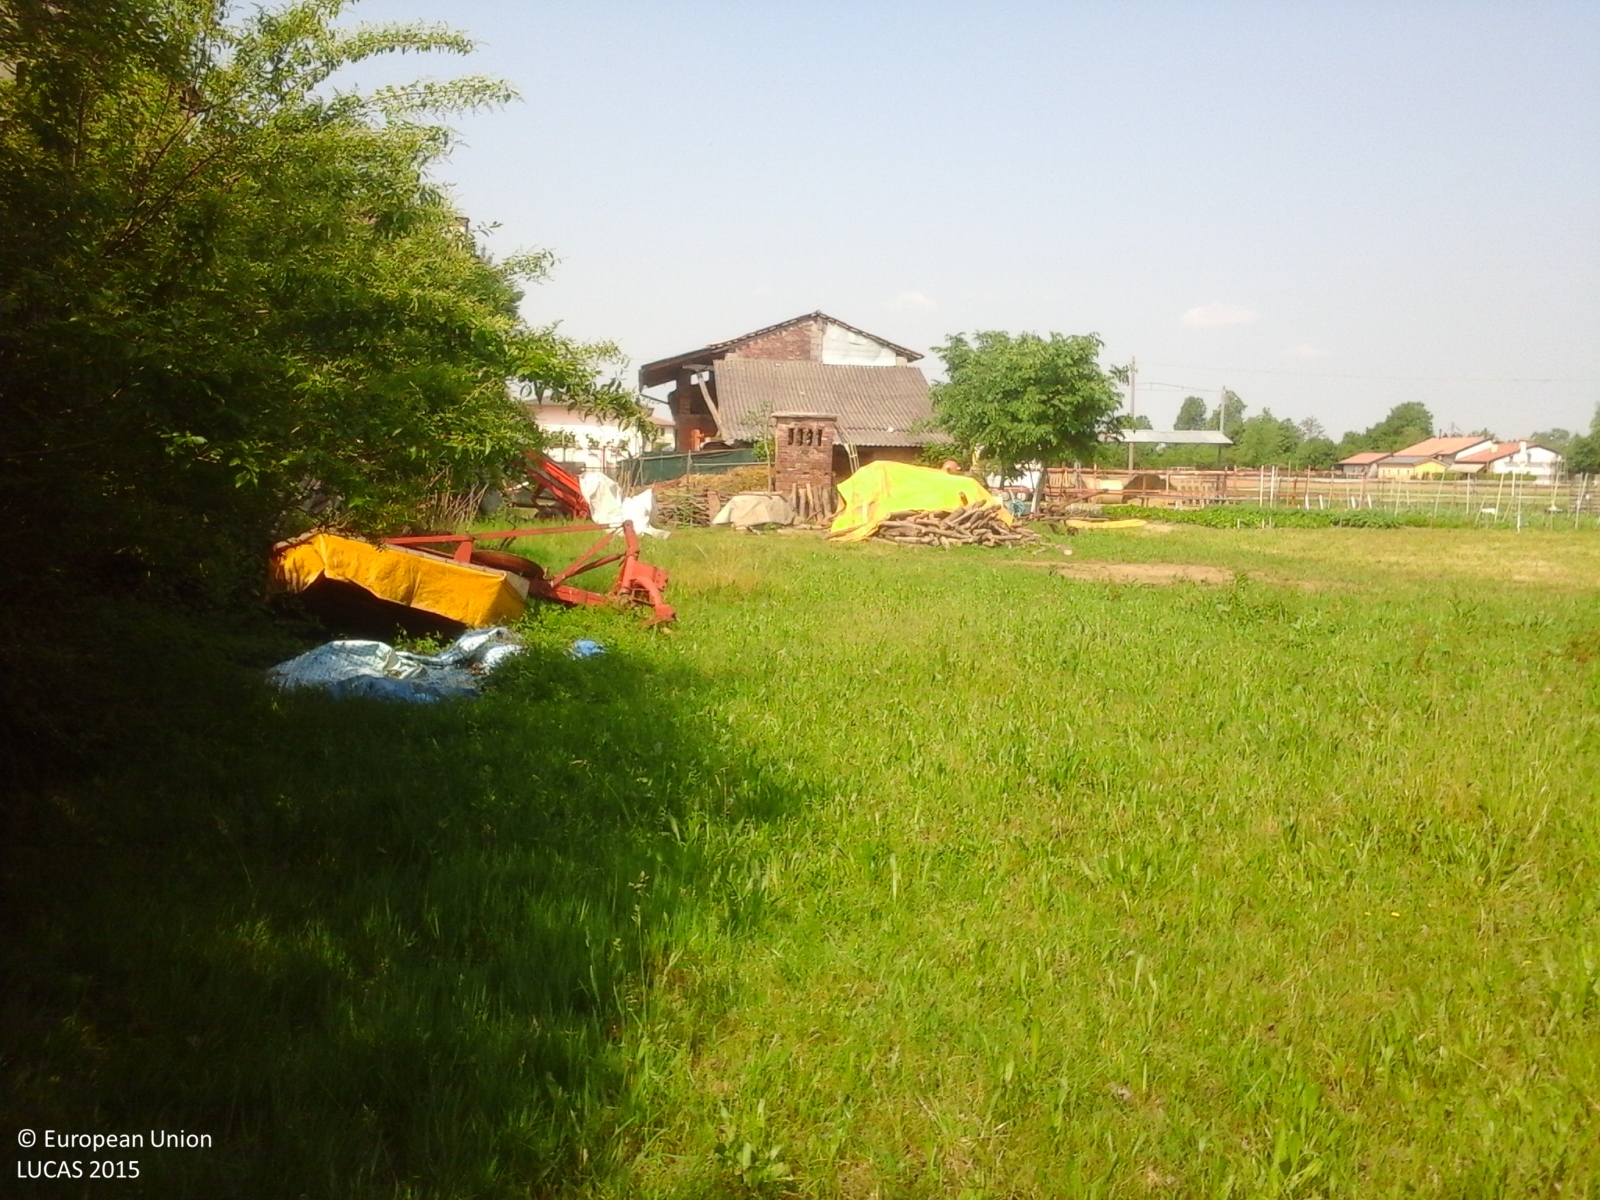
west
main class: Grassland
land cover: Grassland without tree/shrub cover
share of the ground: > 75 %
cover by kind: herbaceous plants 100 %
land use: Residential
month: May
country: IT
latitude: 45.6863
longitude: 11.8590
